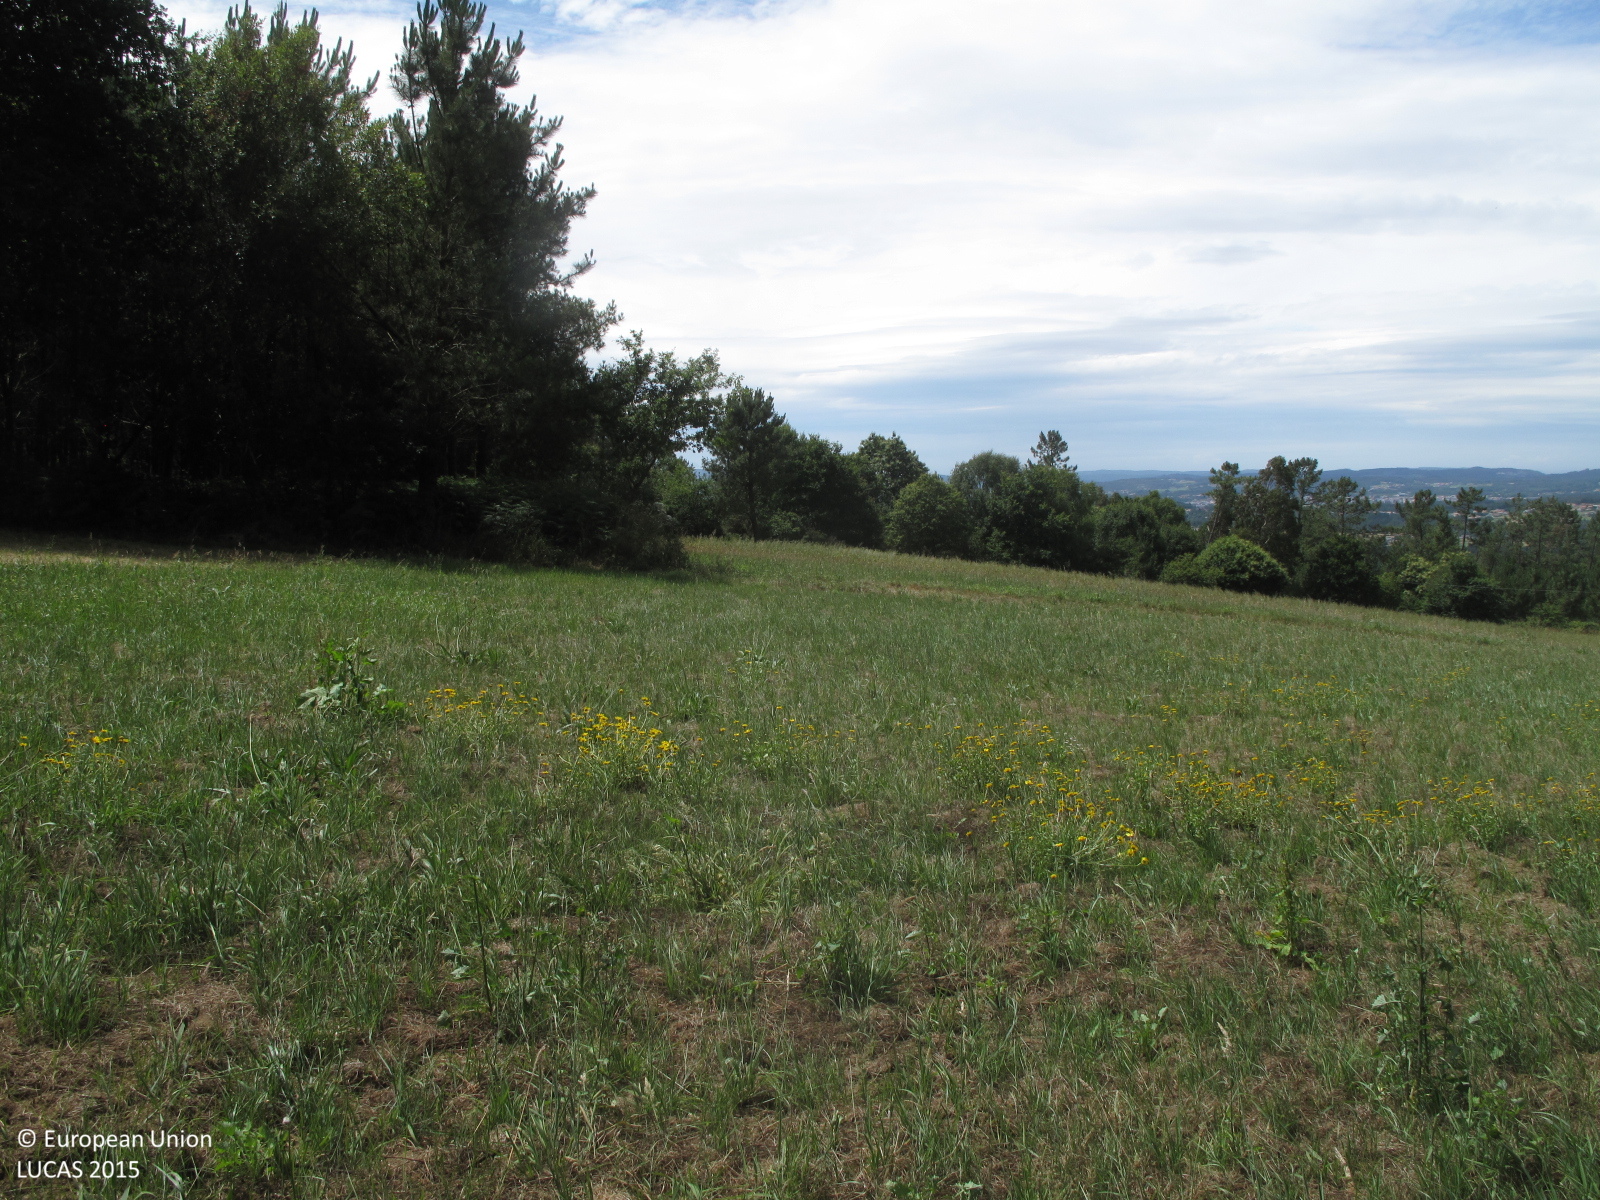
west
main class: Grassland
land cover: Grassland without tree/shrub cover
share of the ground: 50 - 75 %
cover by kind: herbaceous plants 70 %, unconsolidated bare surface 30 %
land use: Agriculture (excluding fallow land and kitchen gardens)
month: July
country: ES
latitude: 43.1856
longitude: -8.6034
